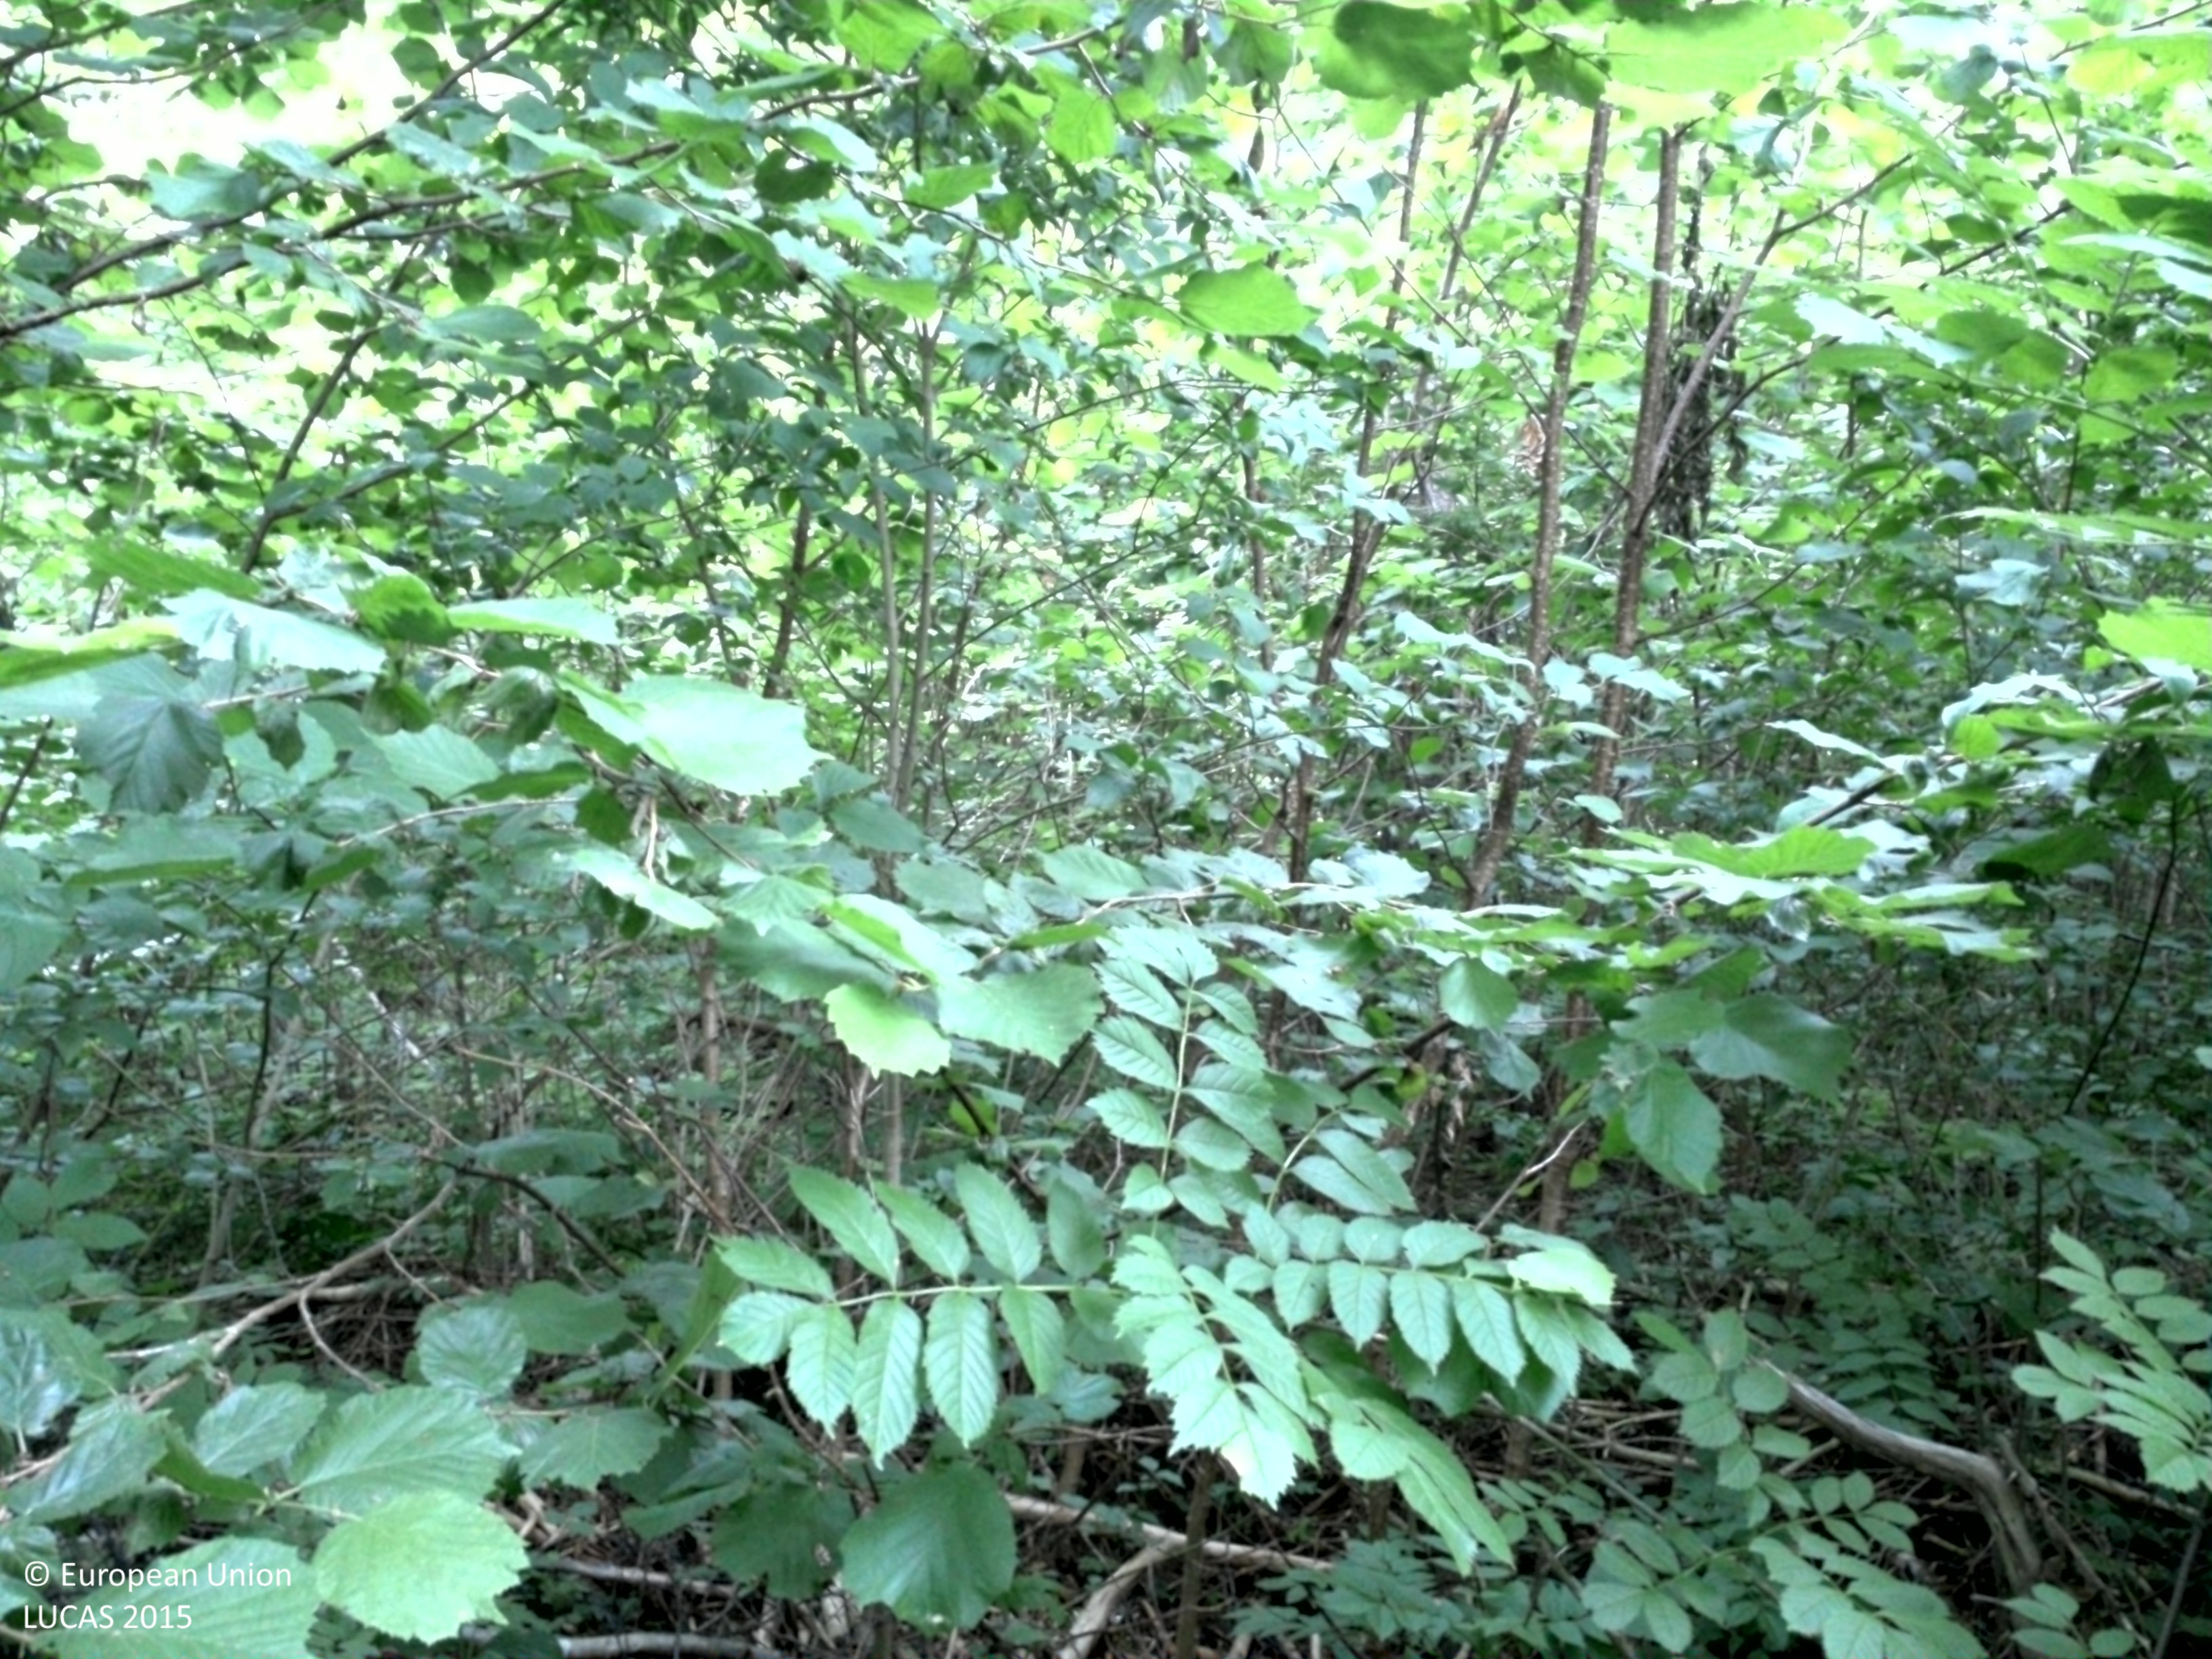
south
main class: Woodland
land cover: Broadleaved woodland
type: mesophytic deciduous forest
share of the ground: > 75 %
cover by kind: broadleaved forest trees 60 %, shrubs 15 %, herbaceous plants 15 %, coniferous forest trees 10 %
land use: Forestry
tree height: > 5 m
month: July
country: SE
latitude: 57.3495
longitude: 18.2673
